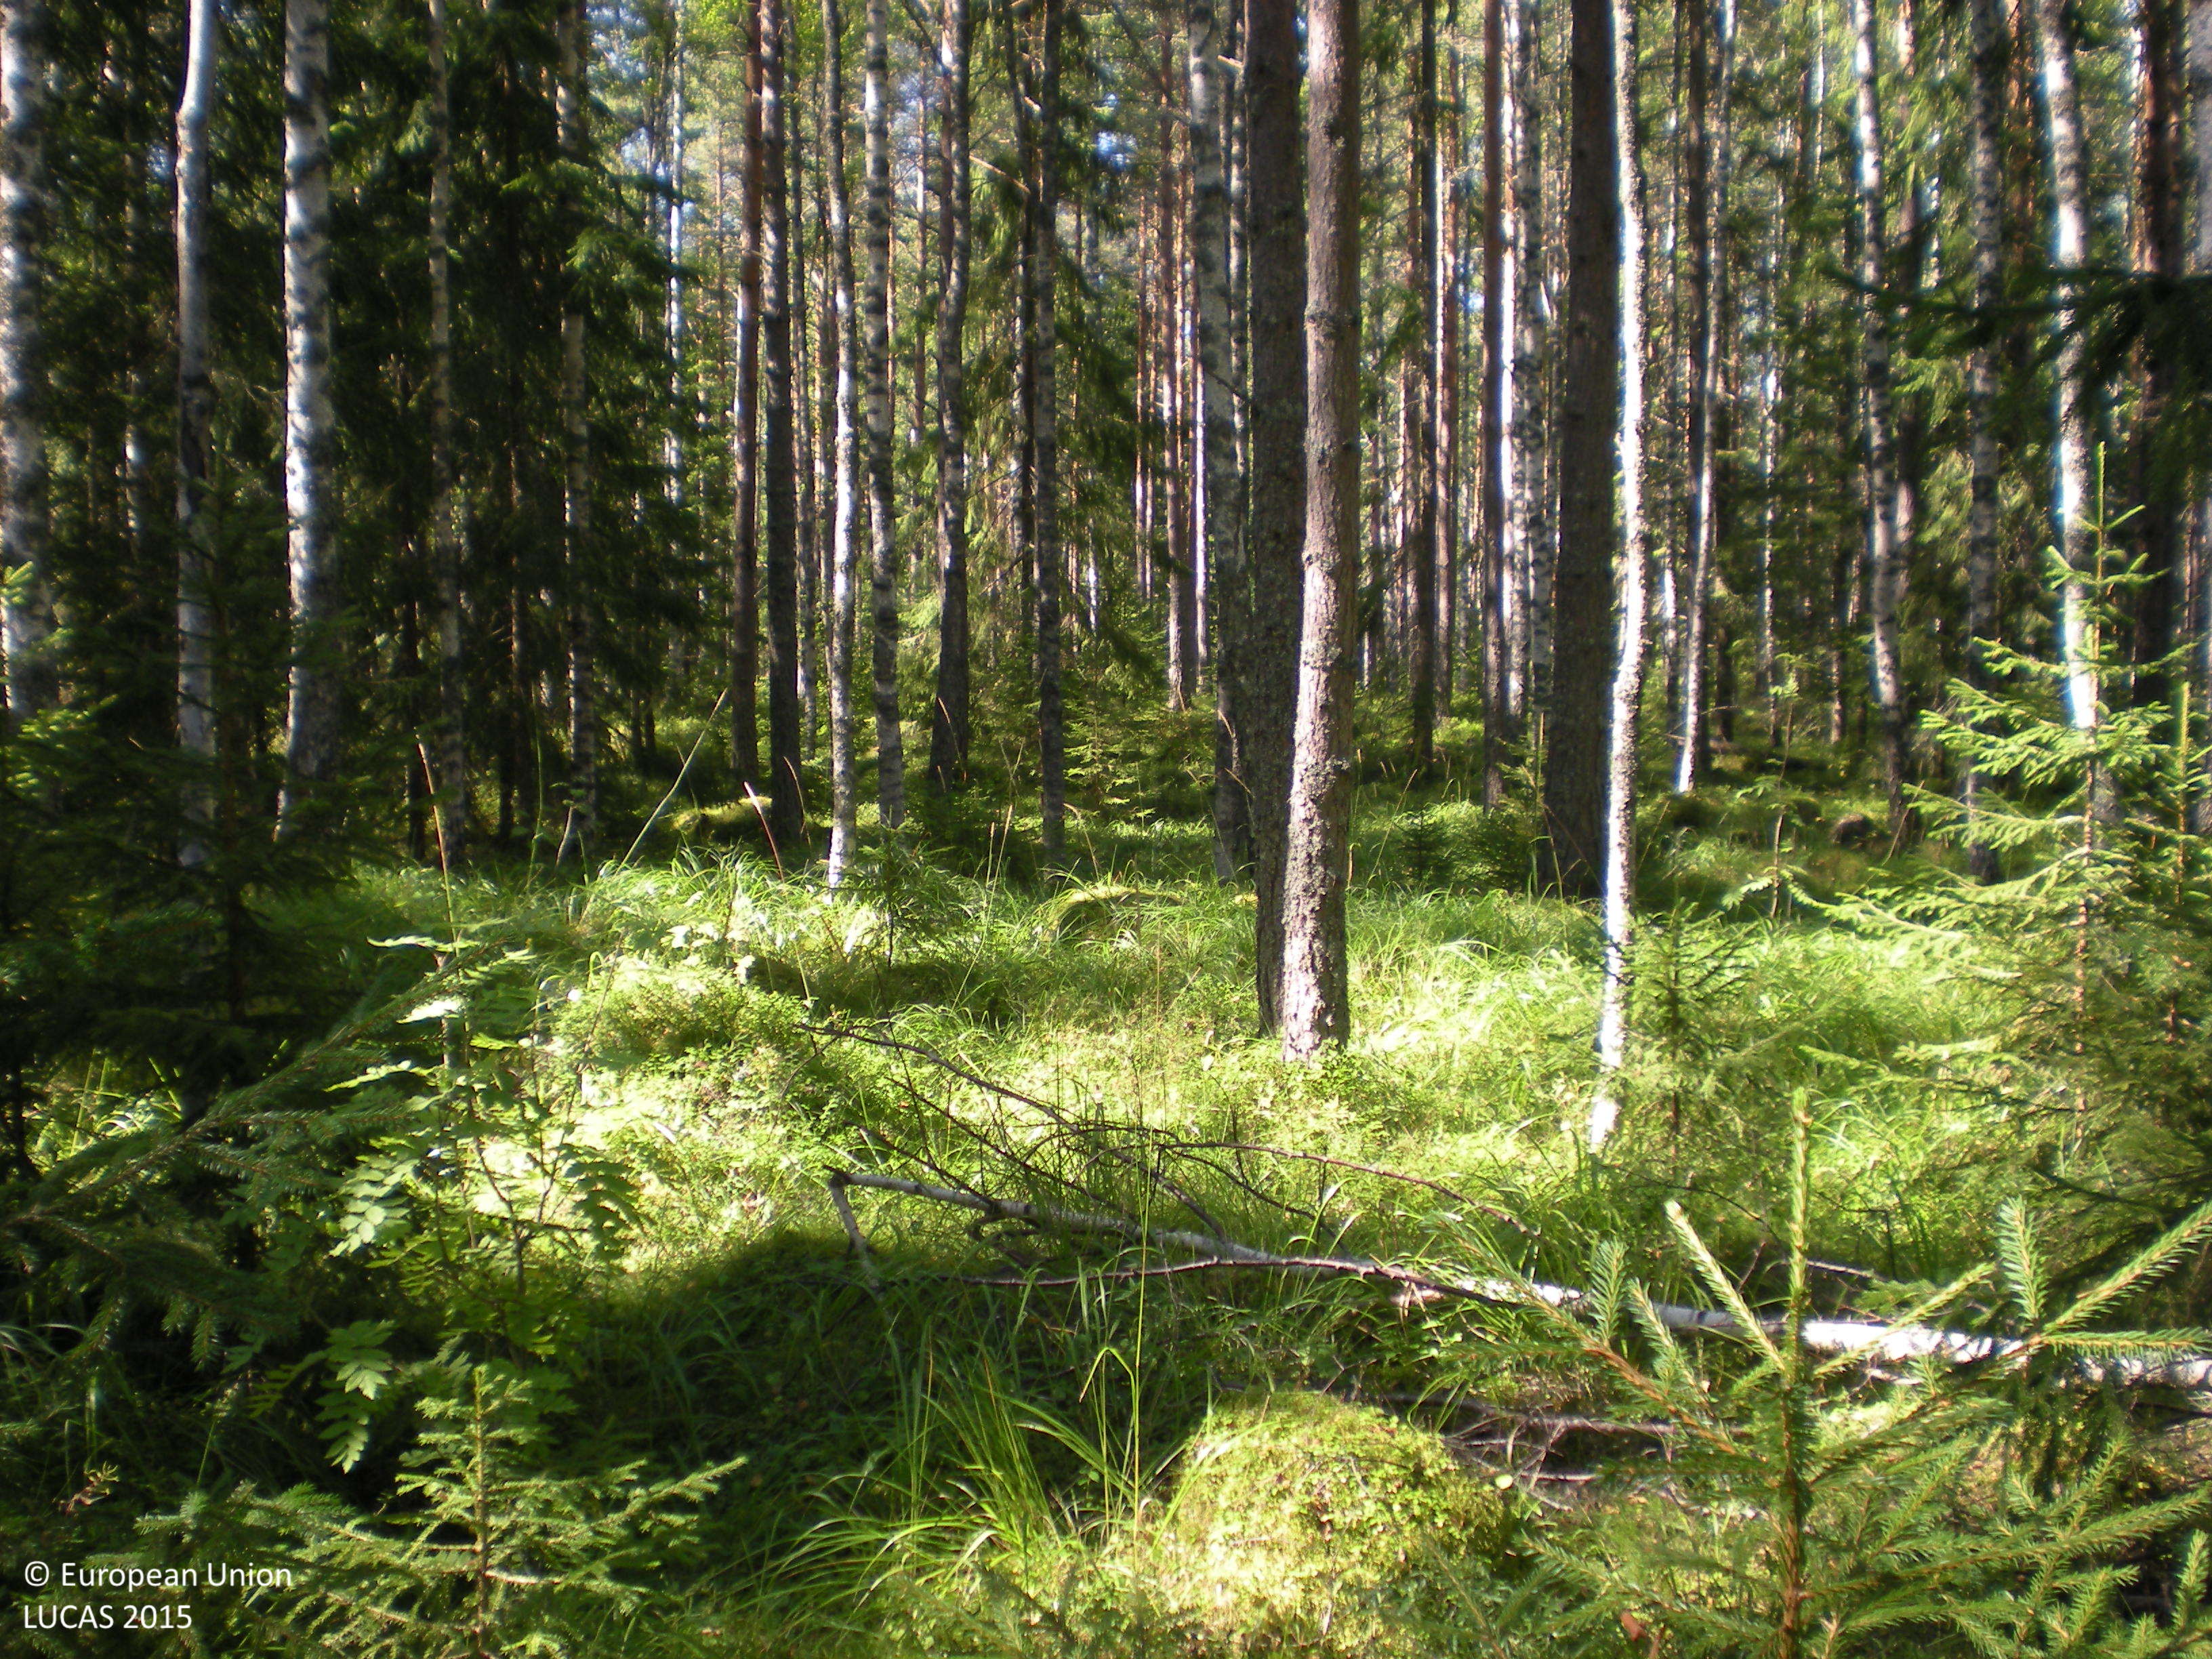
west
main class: Woodland
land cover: Pine dominated mixed woodland
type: boreal forest
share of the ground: 50 - 75 %
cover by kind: coniferous forest trees 50 %, broadleaved forest trees 20 %, herbaceous plants 15 %, shrubs 10 %, lichens and mosses 5 %
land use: Forestry
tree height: > 5 m
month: August
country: SE
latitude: 60.5990
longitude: 17.0929
